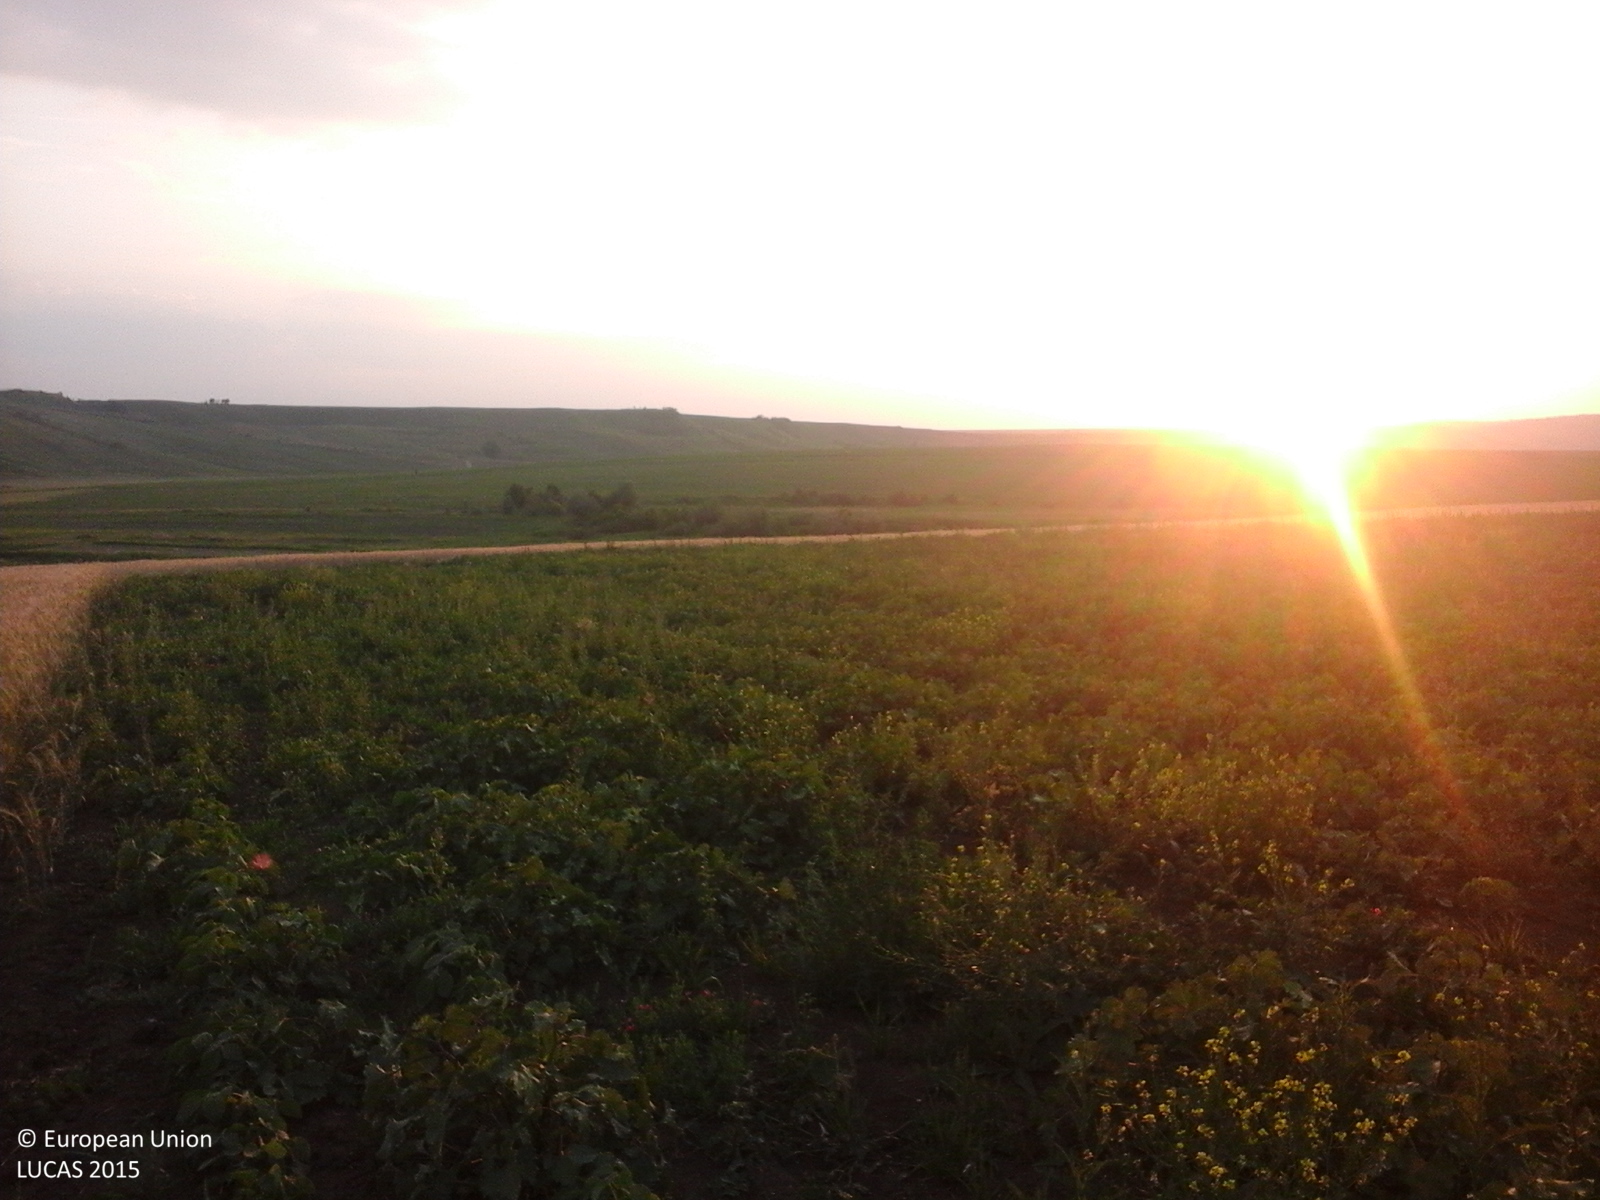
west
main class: Cropland
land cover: Soya
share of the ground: 50 - 75 %
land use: Agriculture (excluding fallow land and kitchen gardens)
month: June
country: RO
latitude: 46.8553
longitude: 27.3294
